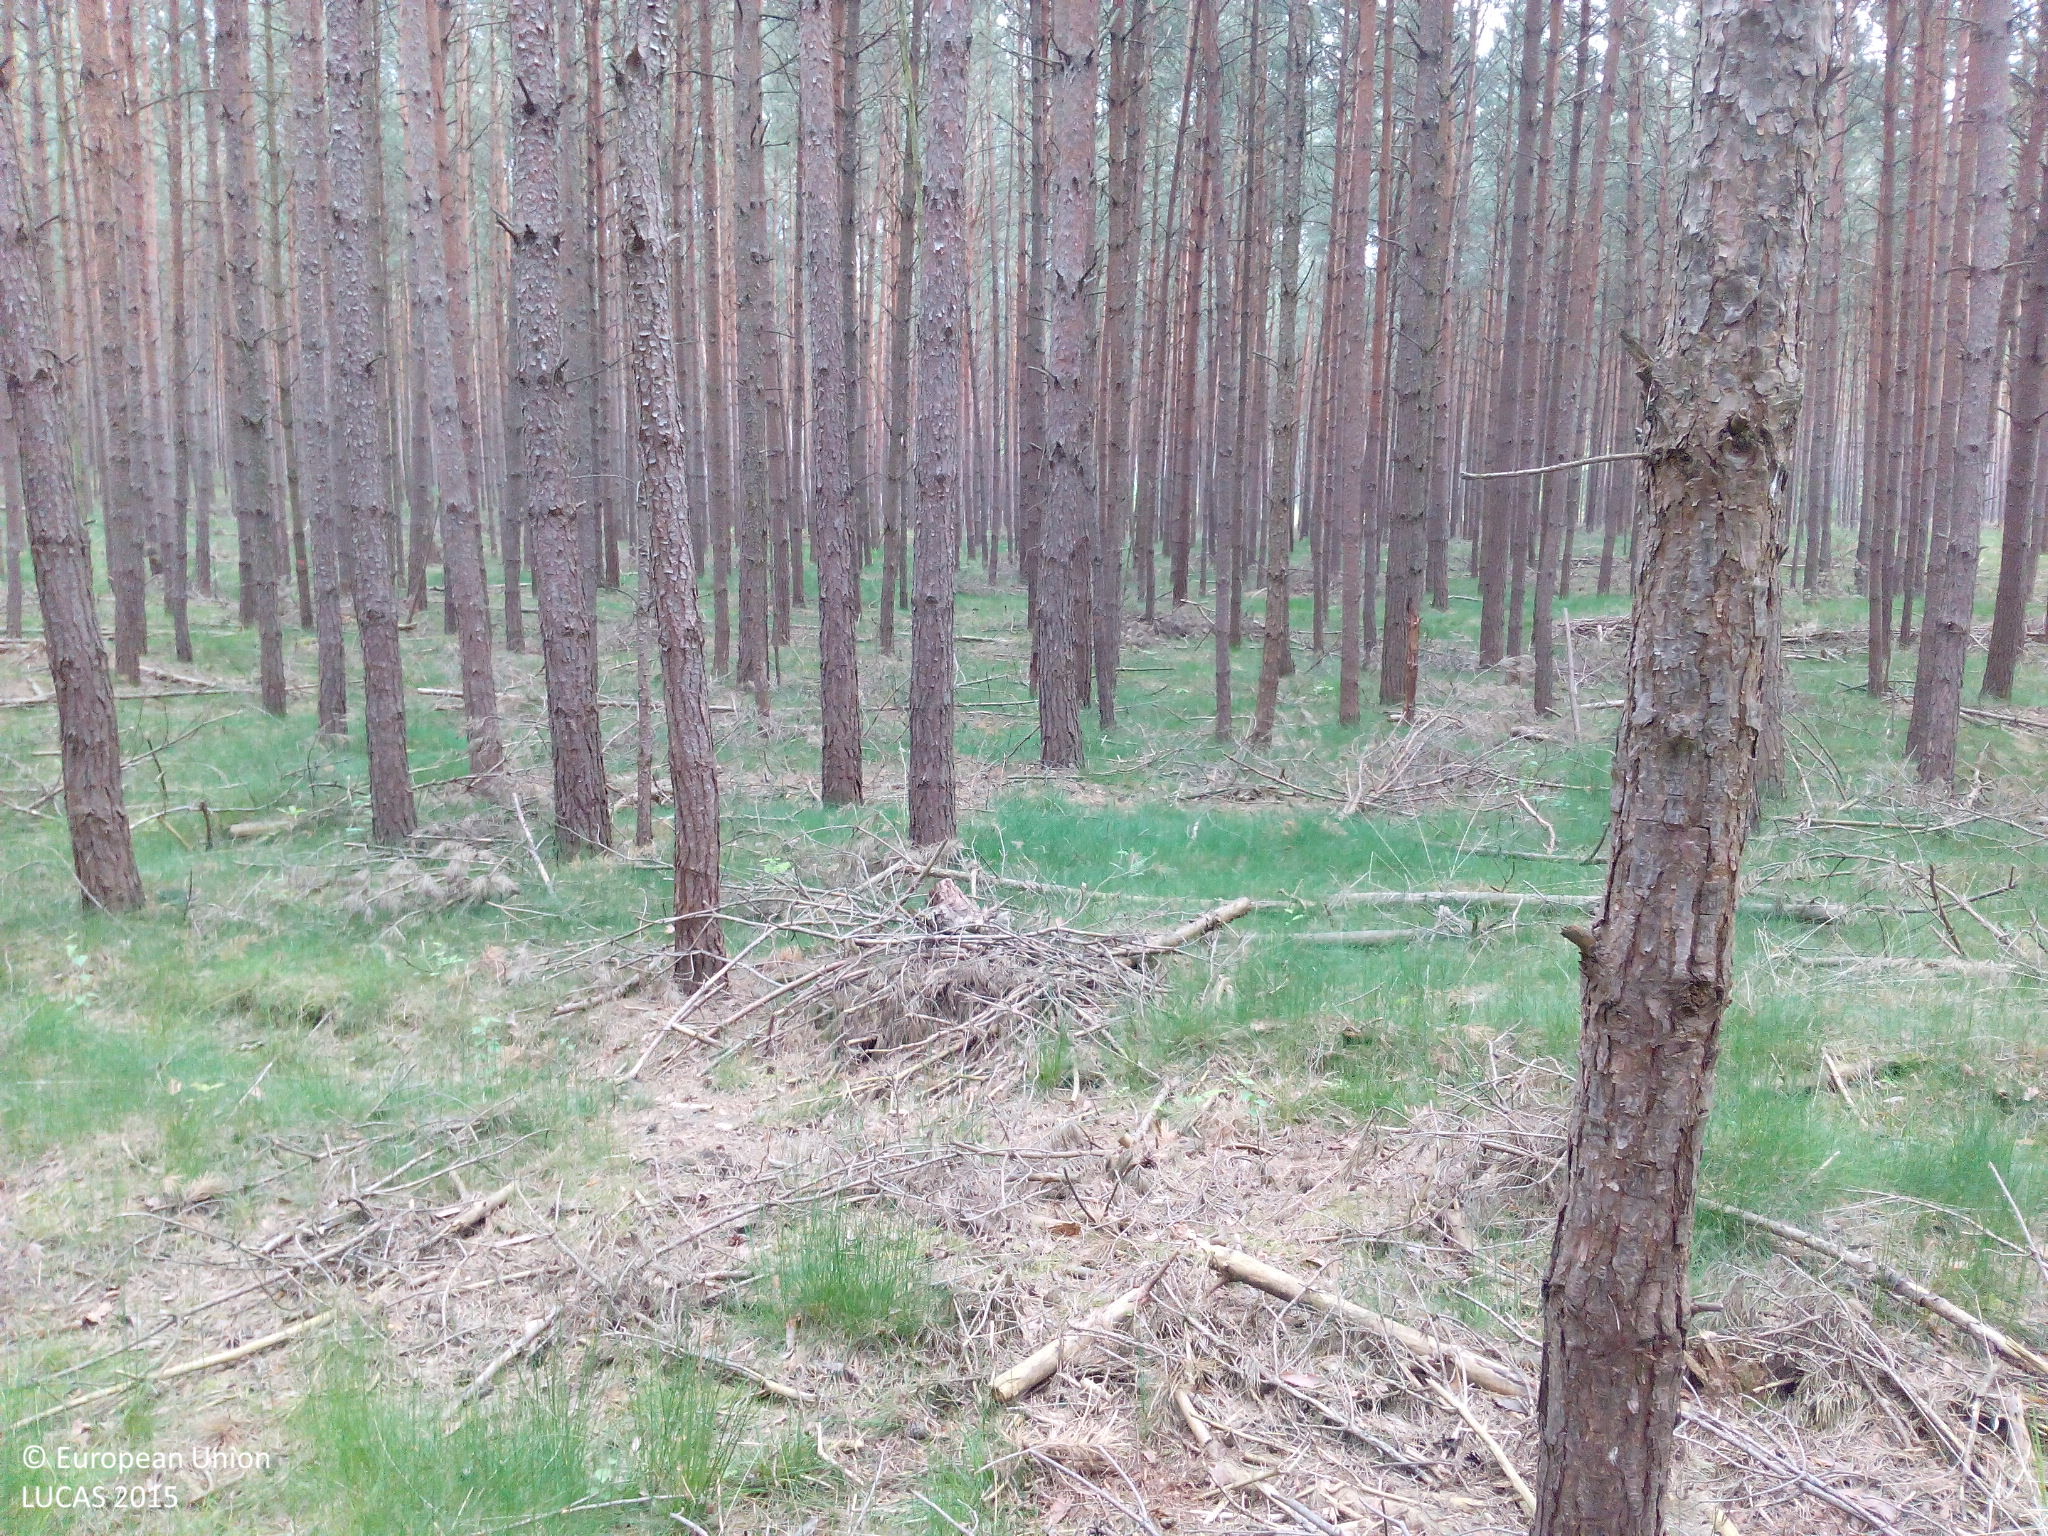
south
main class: Woodland
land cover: Pine dominated coniferous woodland
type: hemiboreal forest and nemoral coniferous forest and mixed broadleaved-coniferous forest
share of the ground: 50 - 75 %
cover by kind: coniferous forest trees 70 %, herbaceous plants 30 %
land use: Forestry
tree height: > 5 m
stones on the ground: < 10 %
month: May
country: DE
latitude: 52.6956
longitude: 11.1389
